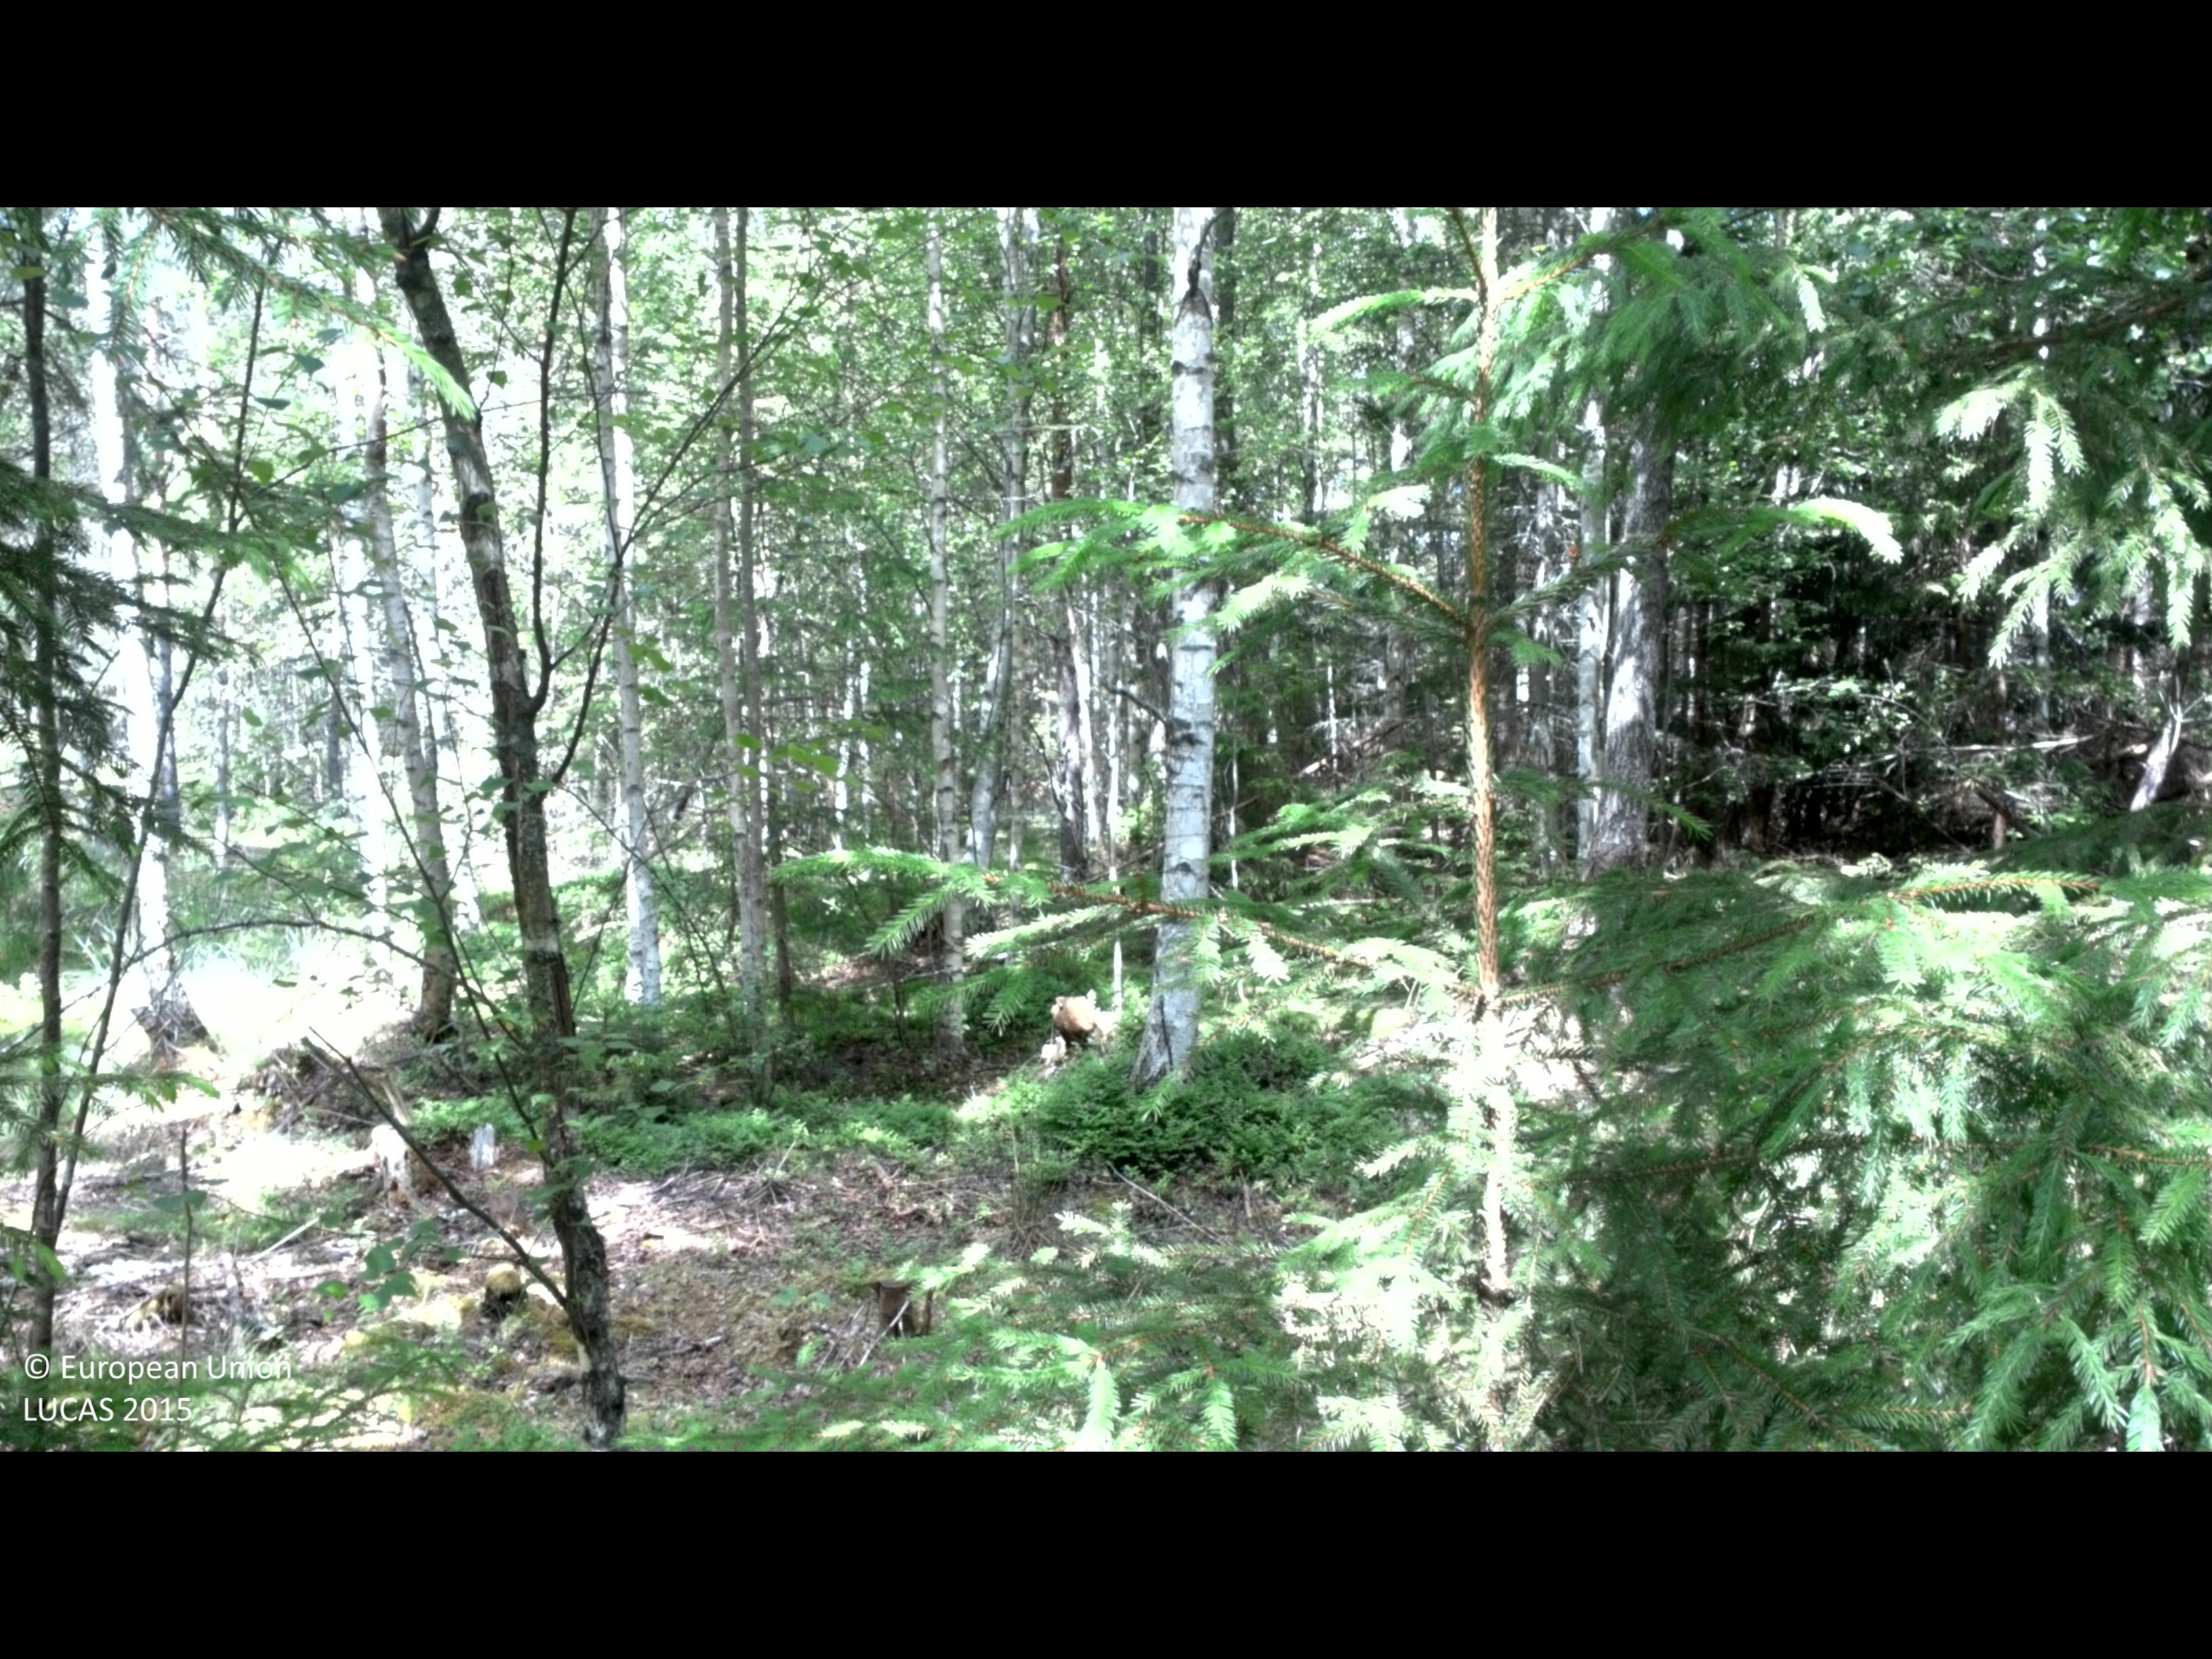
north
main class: Woodland
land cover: Pine dominated mixed woodland
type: boreal forest
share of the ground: > 75 %
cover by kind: coniferous forest trees 45 %, broadleaved forest trees 35 %, shrubs 10 %, lichens and mosses 10 %
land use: Forestry
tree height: > 5 m
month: June
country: SE
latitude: 57.6917
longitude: 16.6926
